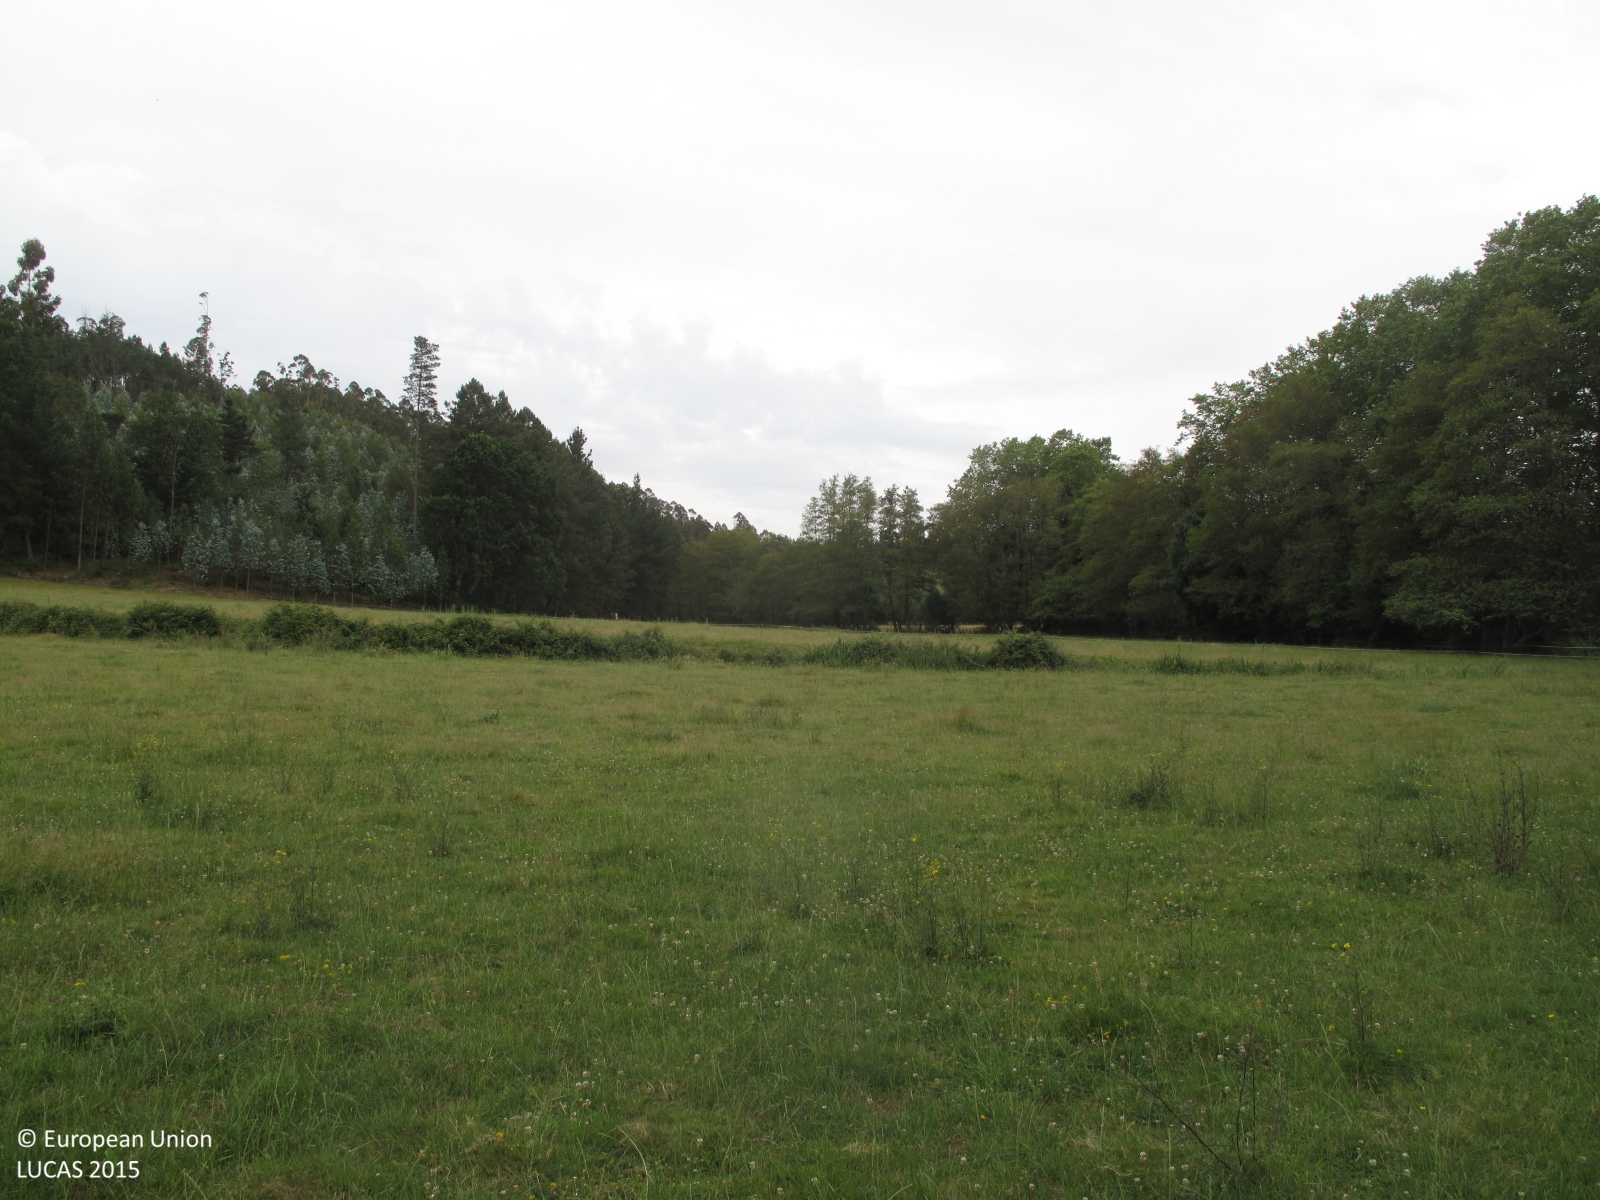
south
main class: Grassland
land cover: Grassland without tree/shrub cover
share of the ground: > 75 %
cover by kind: herbaceous plants 100 %
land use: Agriculture (excluding fallow land and kitchen gardens)
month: July
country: ES
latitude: 43.2341
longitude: -8.2379
